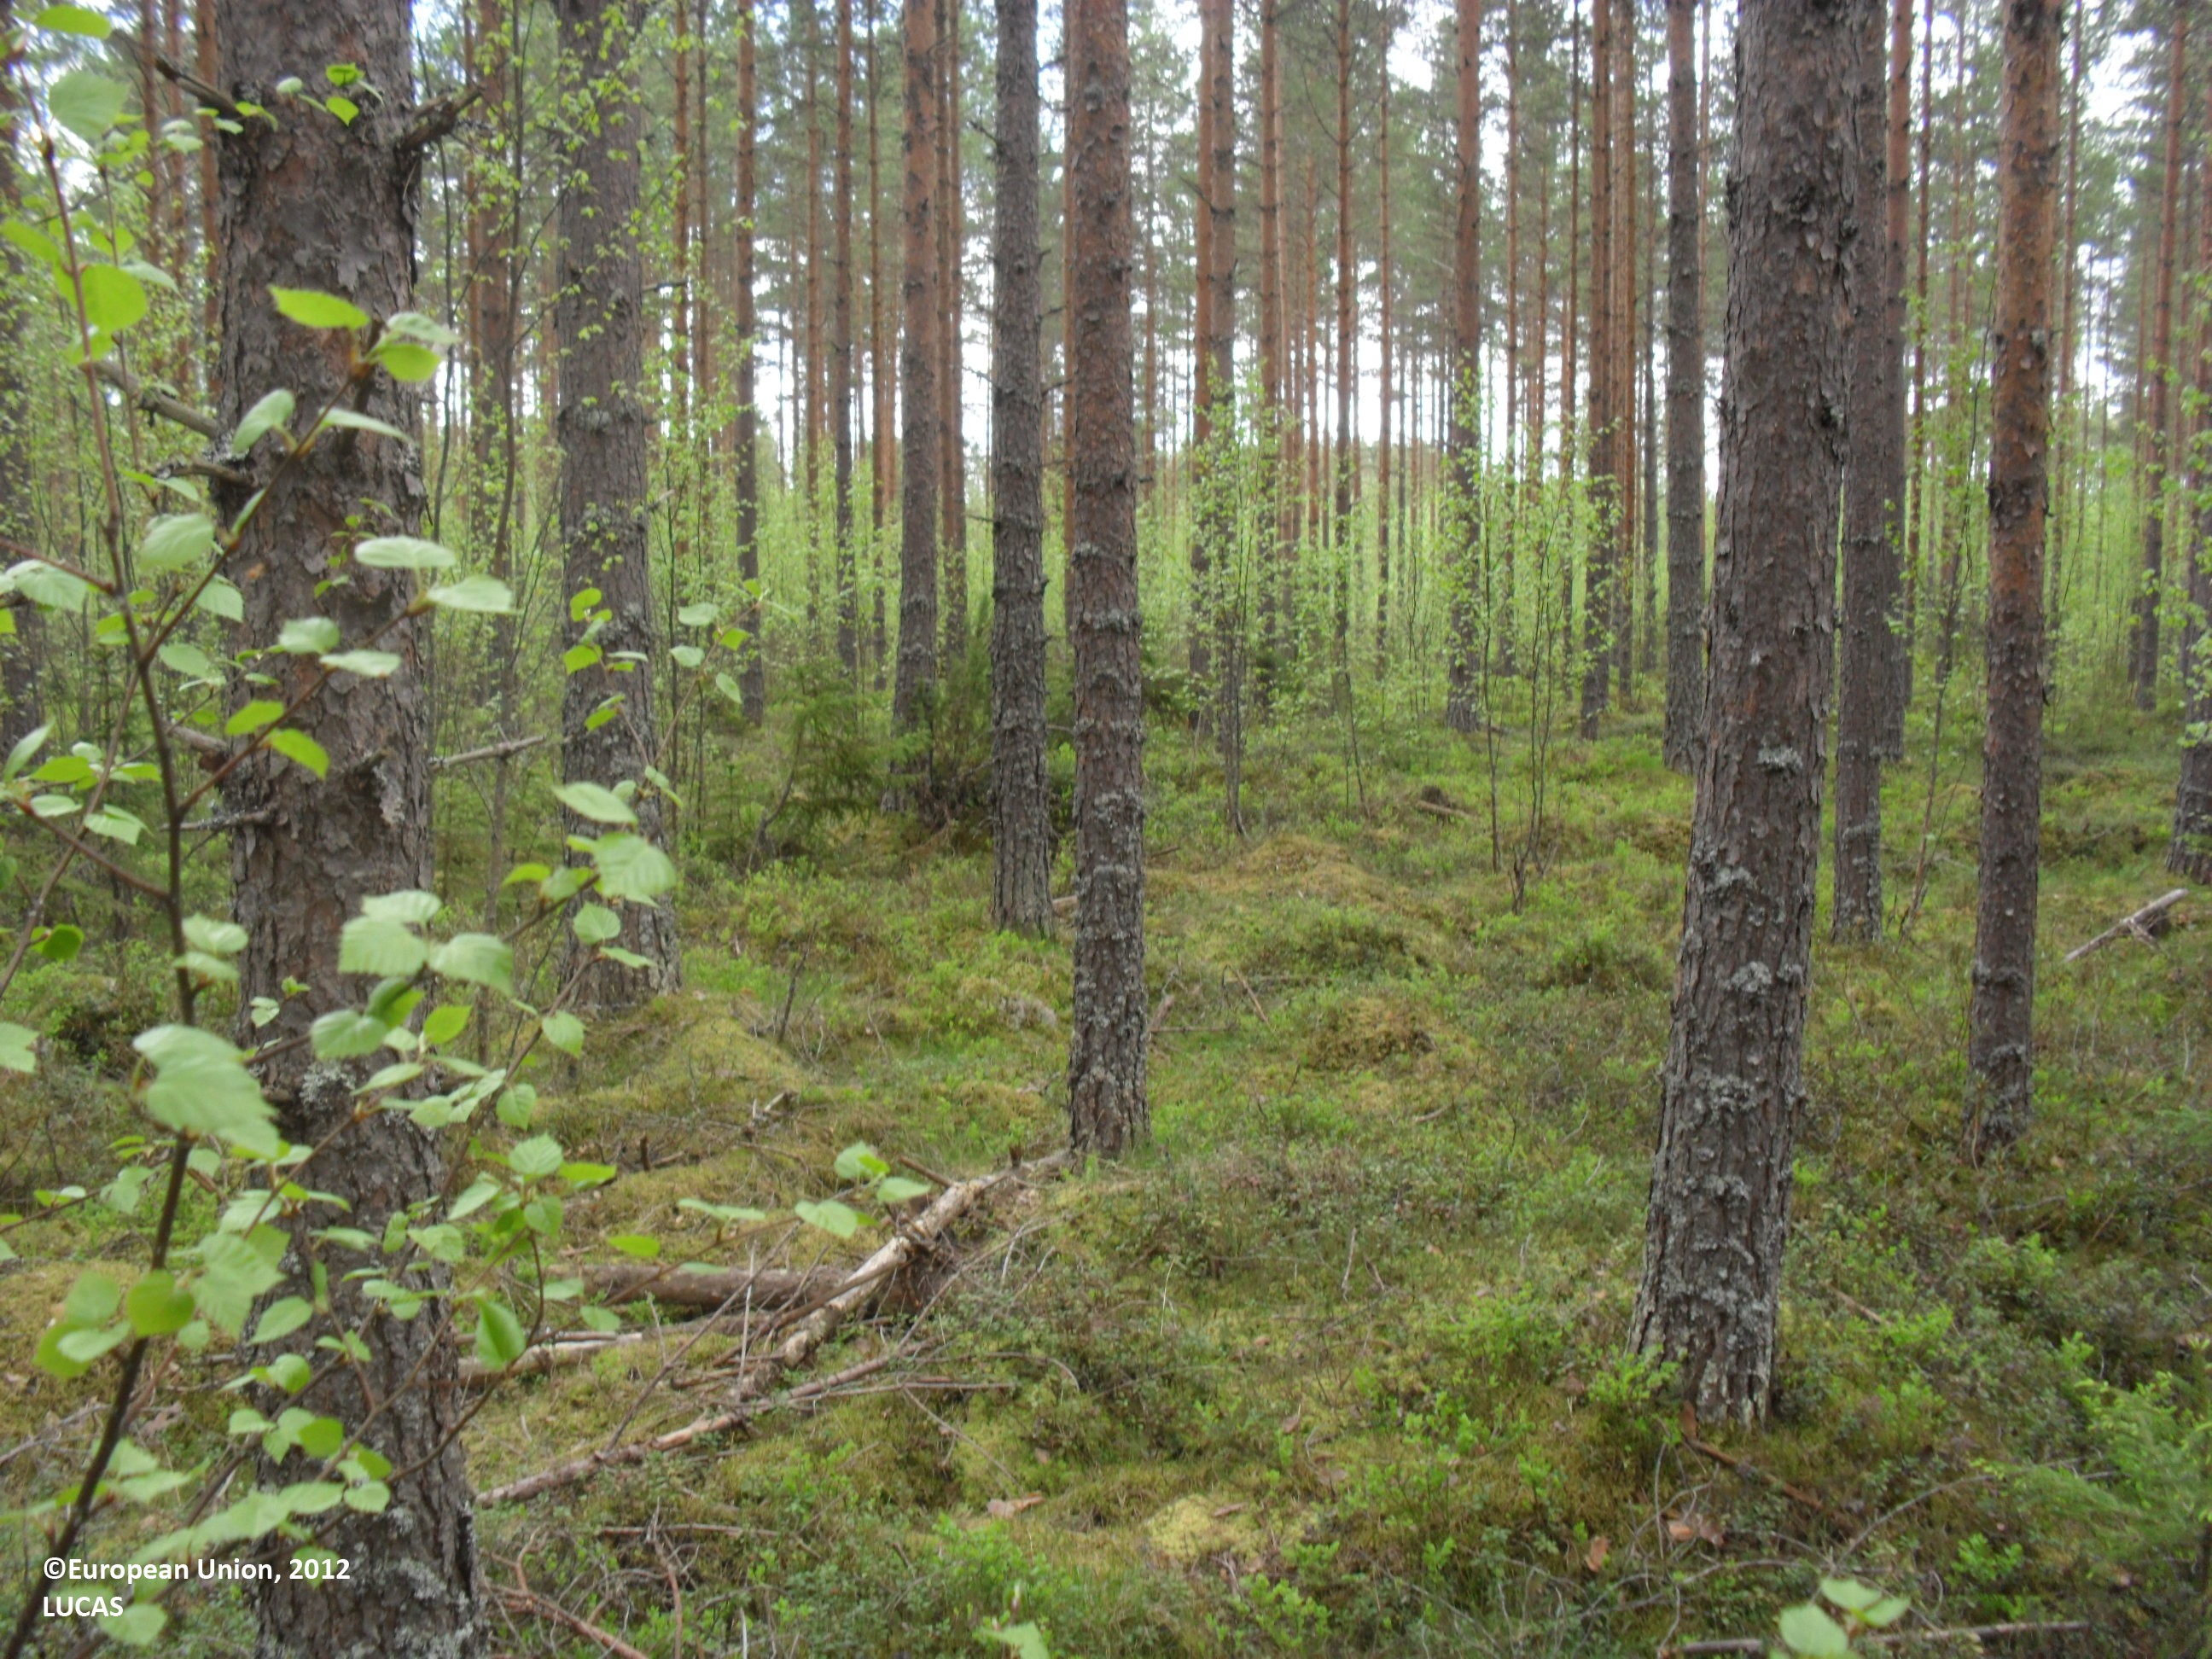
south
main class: Woodland
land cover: Pine dominated coniferous woodland
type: boreal forest
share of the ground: 50 - 75 %
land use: Forestry
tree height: > 5 m
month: June
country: FI
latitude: 63.0996
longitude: 23.3164
